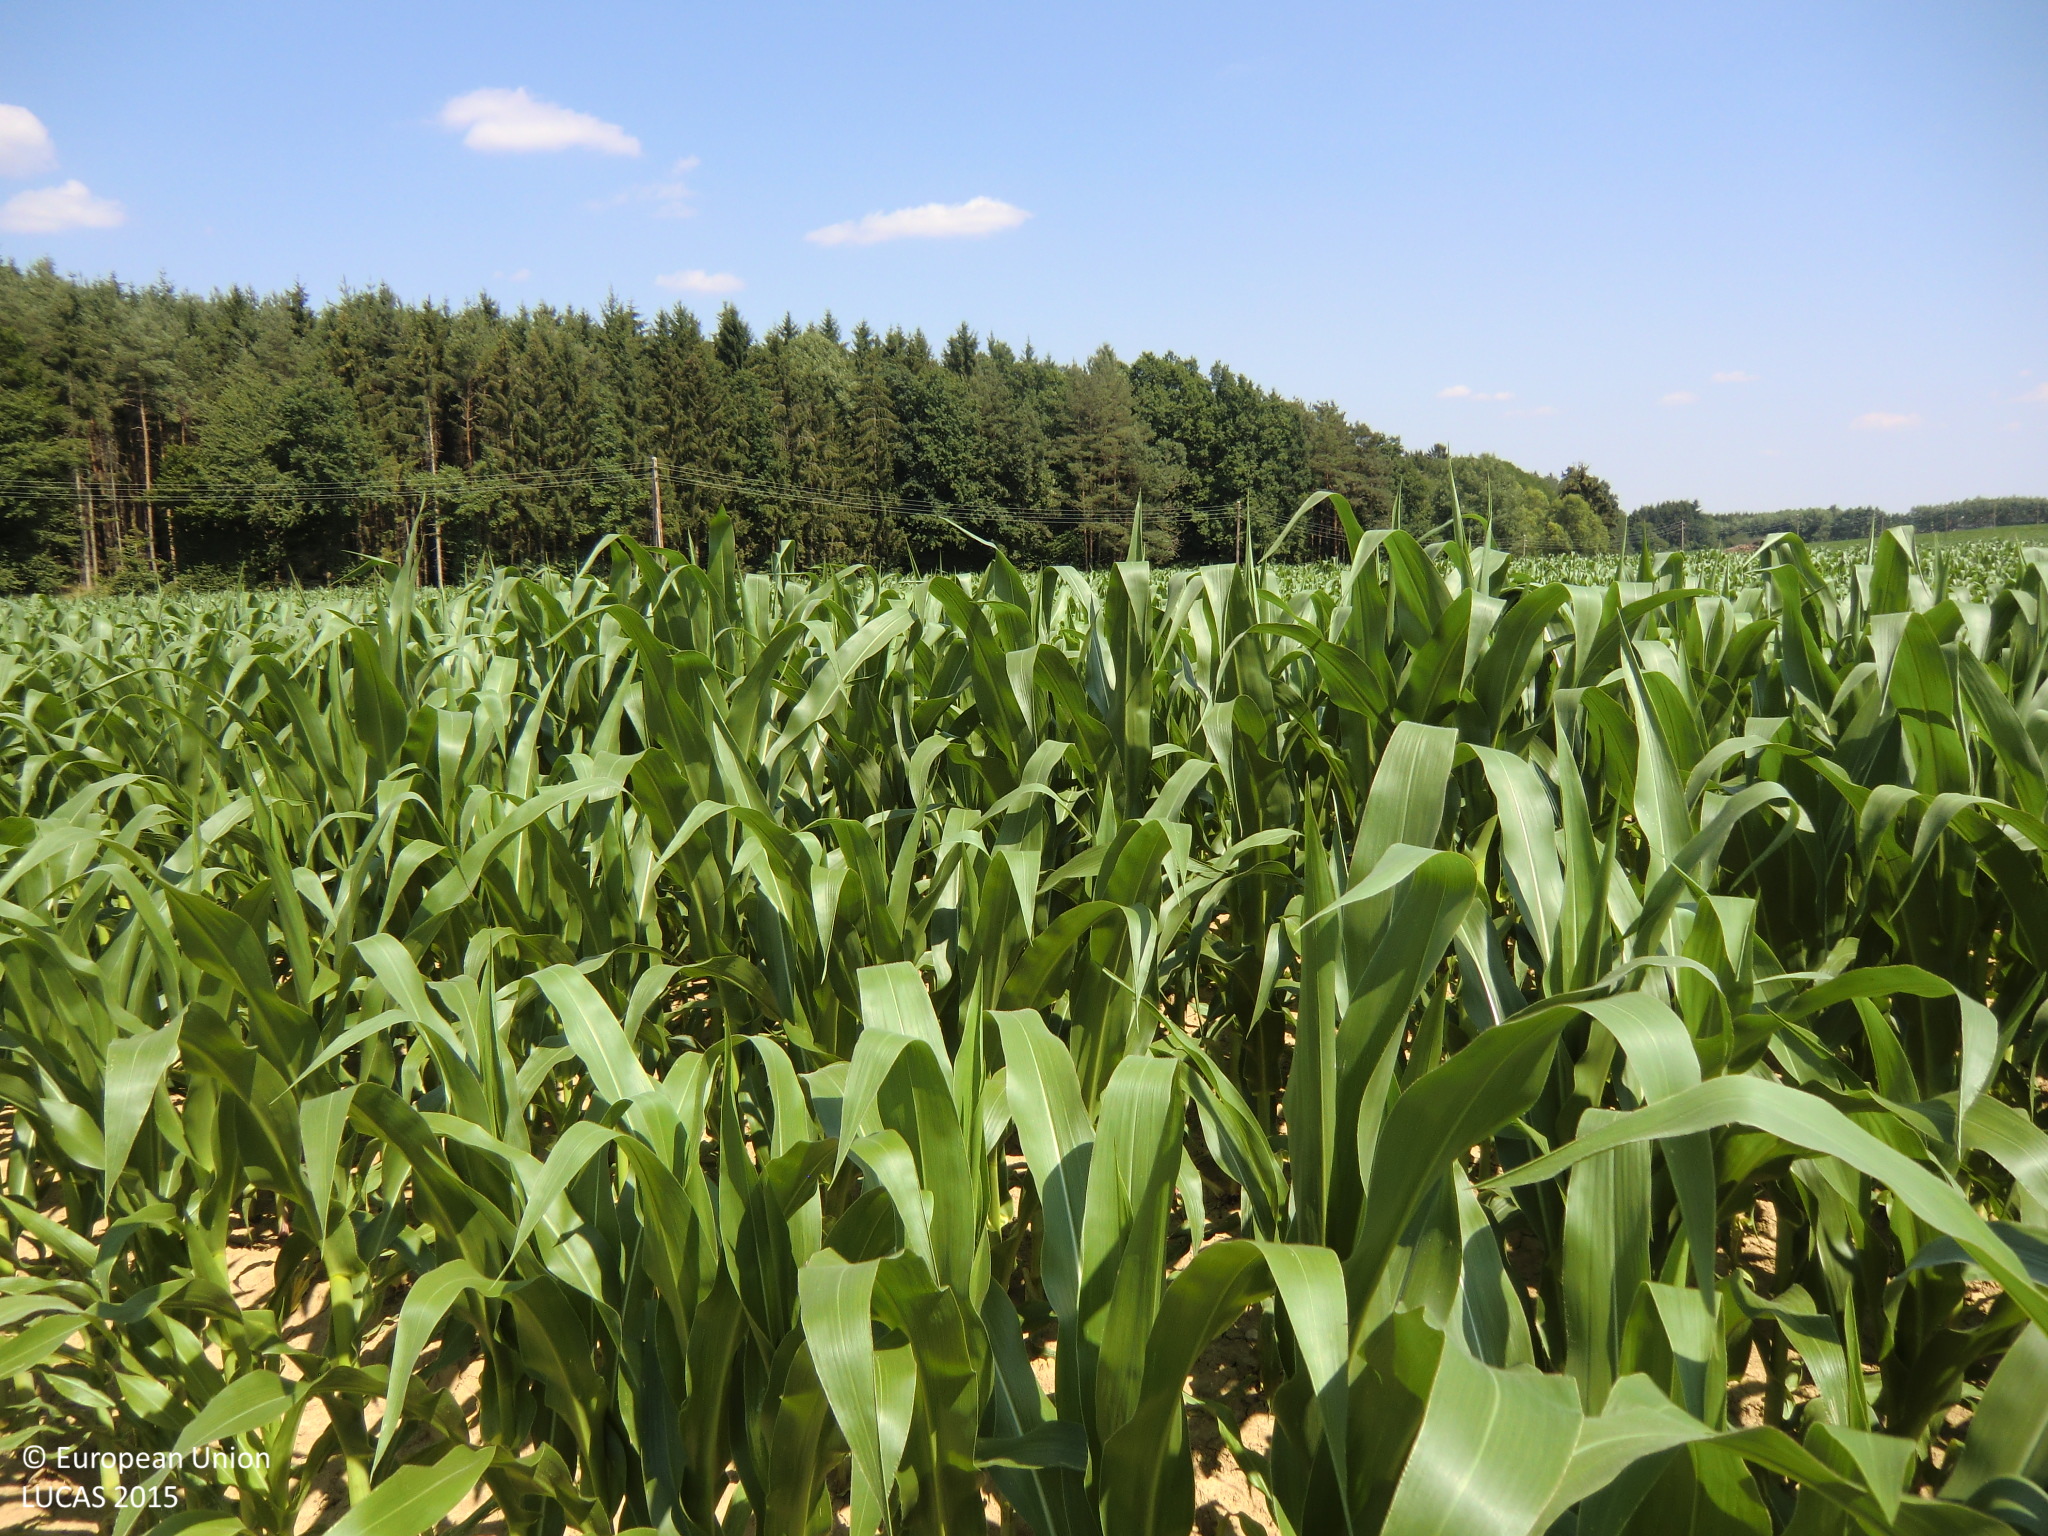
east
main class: Cropland
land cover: Barley
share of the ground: > 75 %
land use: Agriculture (excluding fallow land and kitchen gardens)
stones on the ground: < 10 %
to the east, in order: Barley; Maize; Electric lines; Maize; Grass margins; Ditches and canals; Grass margins; Tracks; Grass margins; Ditches and canals; Spruce dominated coniferous woodland; Tracks; Spruce dominated mixed woodland; Pine dominated mixed woodland
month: July
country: AT
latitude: 47.1203
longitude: 16.0250
